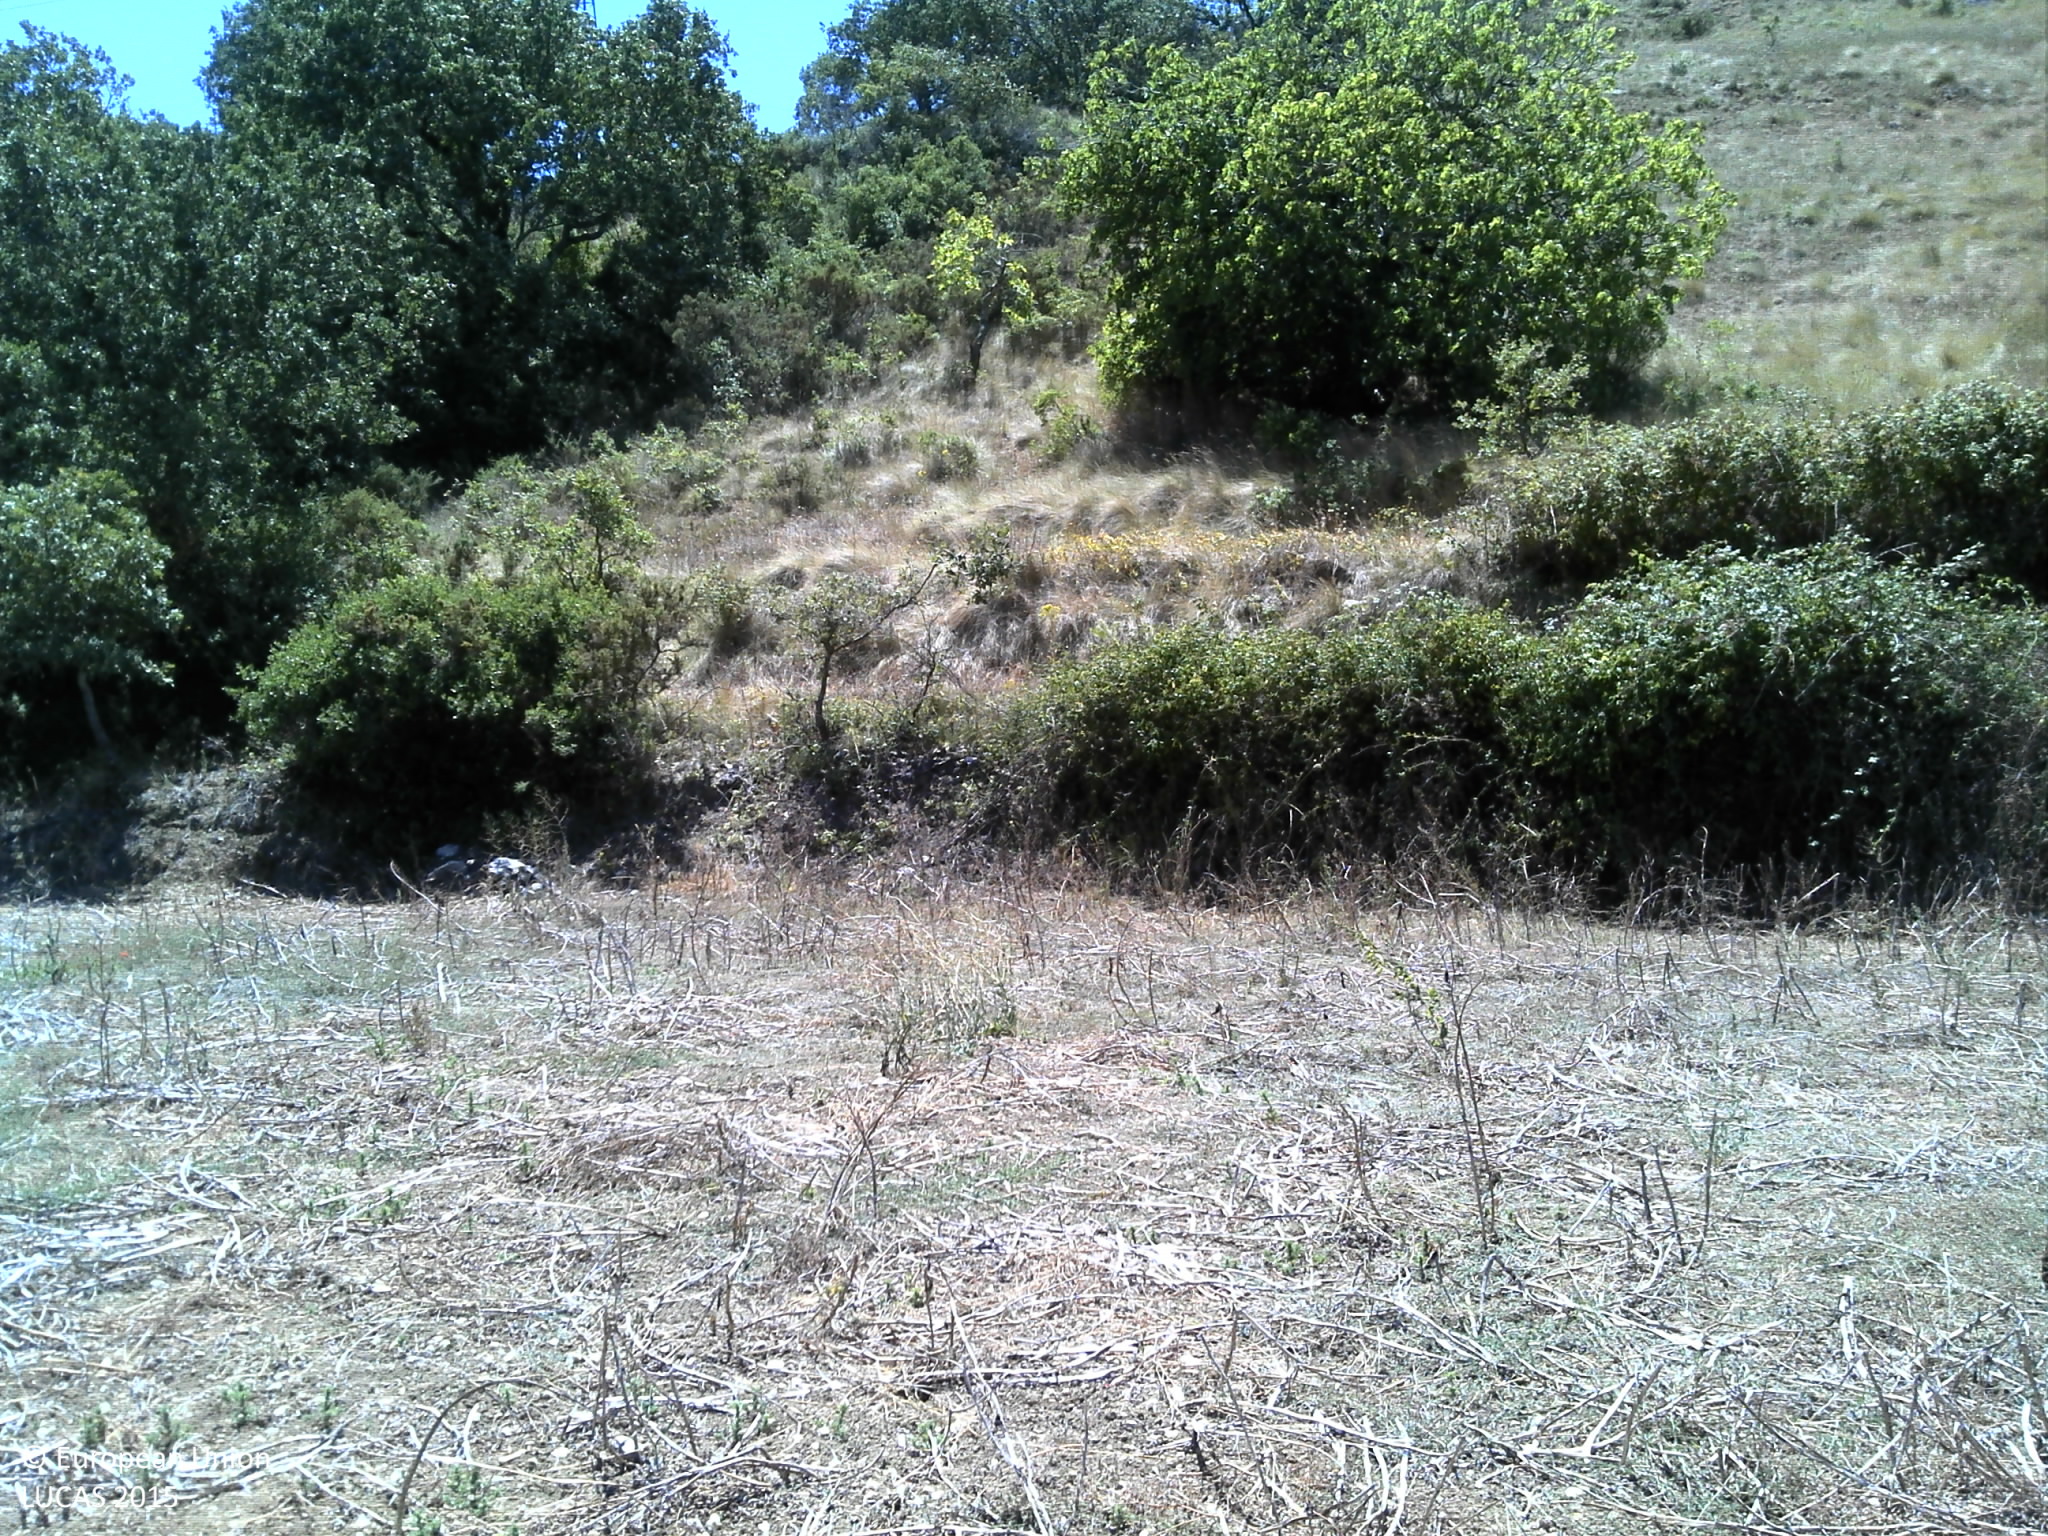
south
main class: Shrubland
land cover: Shrubland with sparse tree cover
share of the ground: 50 - 75 %
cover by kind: shrubs 50 %, herbaceous plants 25 %, coniferous forest trees 5 %, unconsolidated bare surface 5 %
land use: Forestry
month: July
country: PT
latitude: 38.9486
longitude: -9.1769
